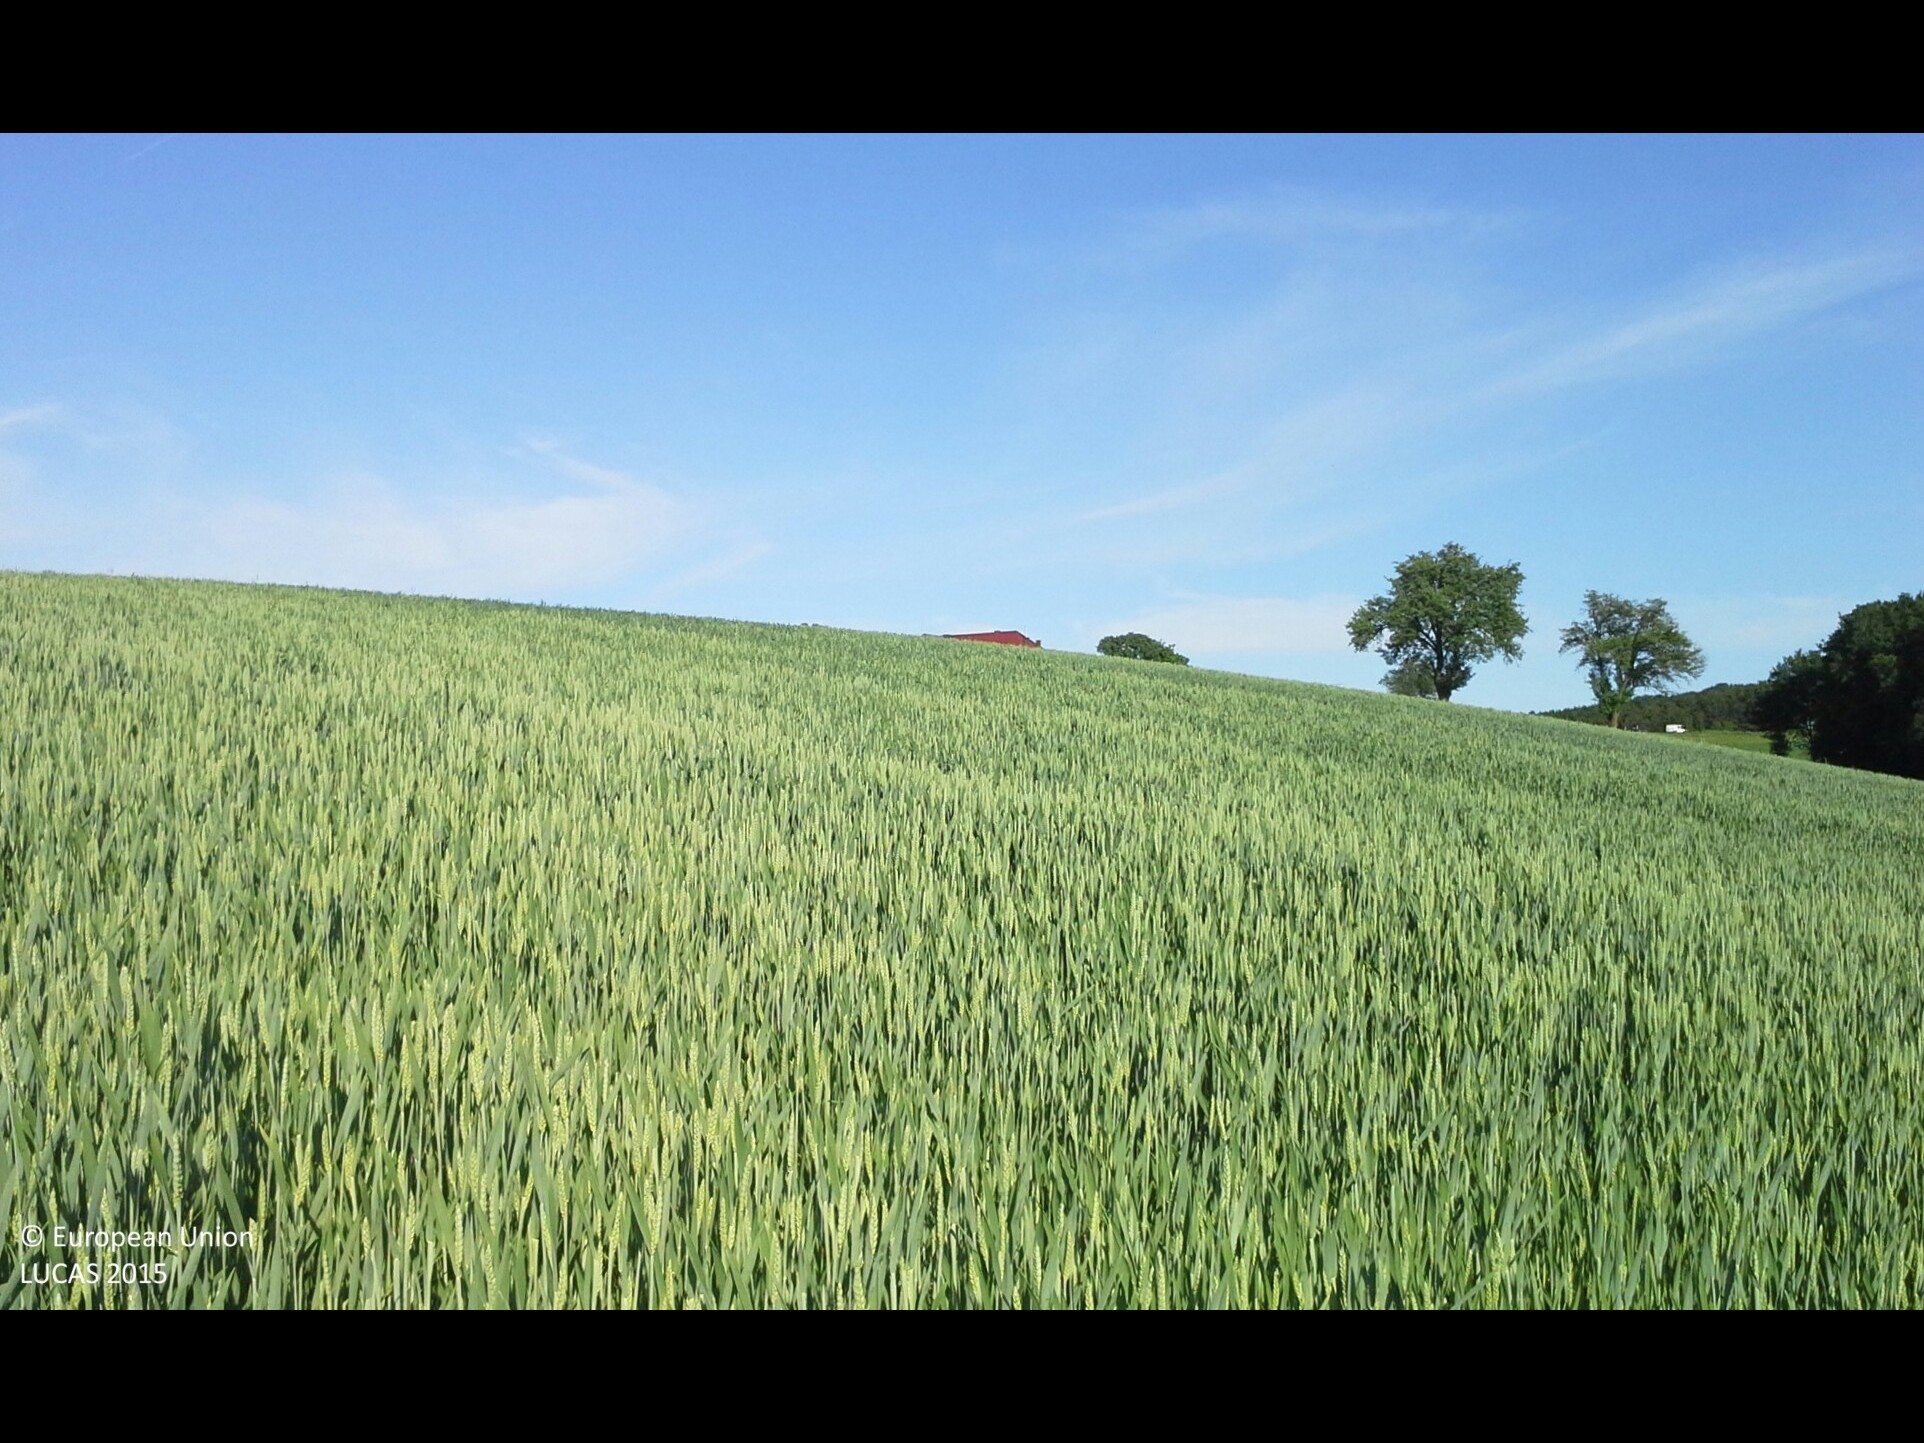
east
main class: Cropland
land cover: Common wheat
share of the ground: > 75 %
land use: Agriculture (excluding fallow land and kitchen gardens)
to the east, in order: Common wheat; Grass margins; Ditches and canals; Grass margins; Paved roads, cycling and walking lanes; Grass margins; Grassland without tree/shrub cover; Barley; Common wheat
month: June
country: AT
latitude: 48.1227
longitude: 14.7160
